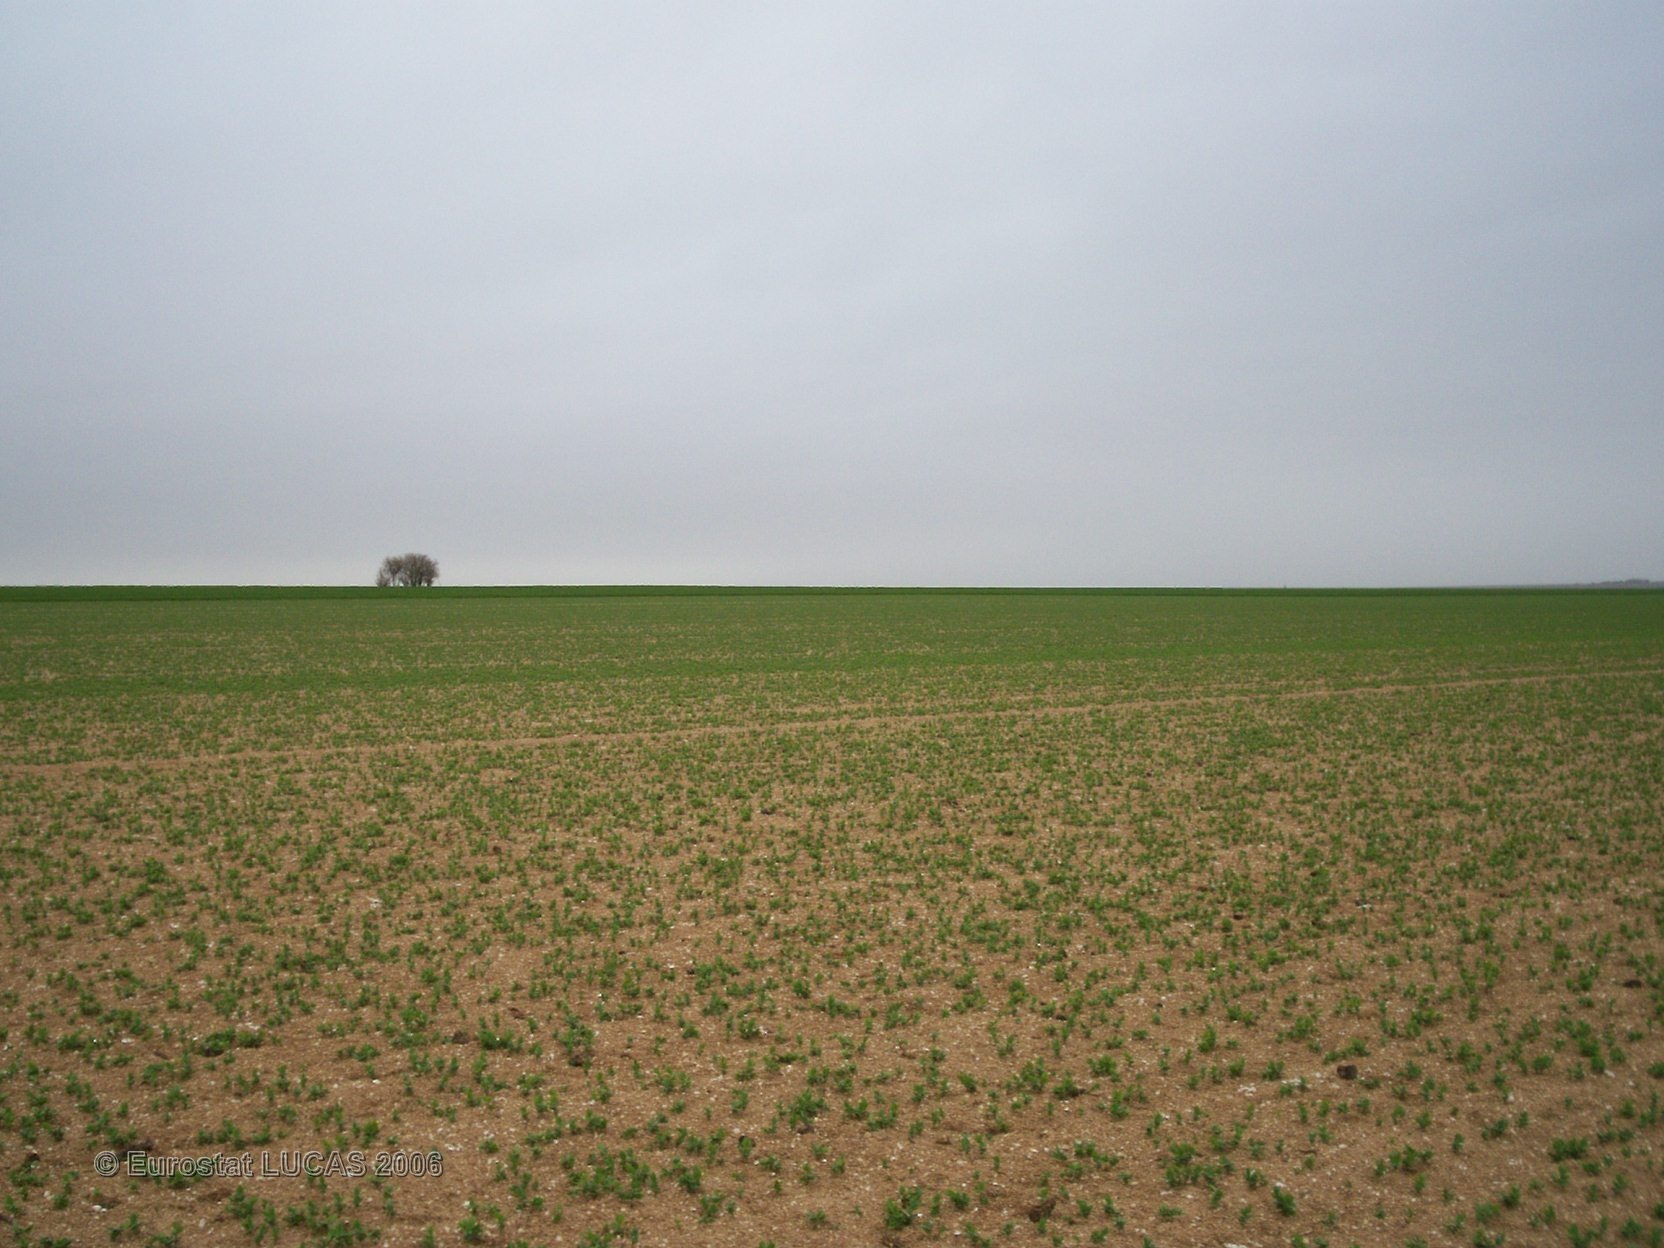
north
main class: Cropland
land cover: Dry pulses
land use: Agriculture (excluding fallow land and kitchen gardens)
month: April
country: FR
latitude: 49.2523
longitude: 4.3770
